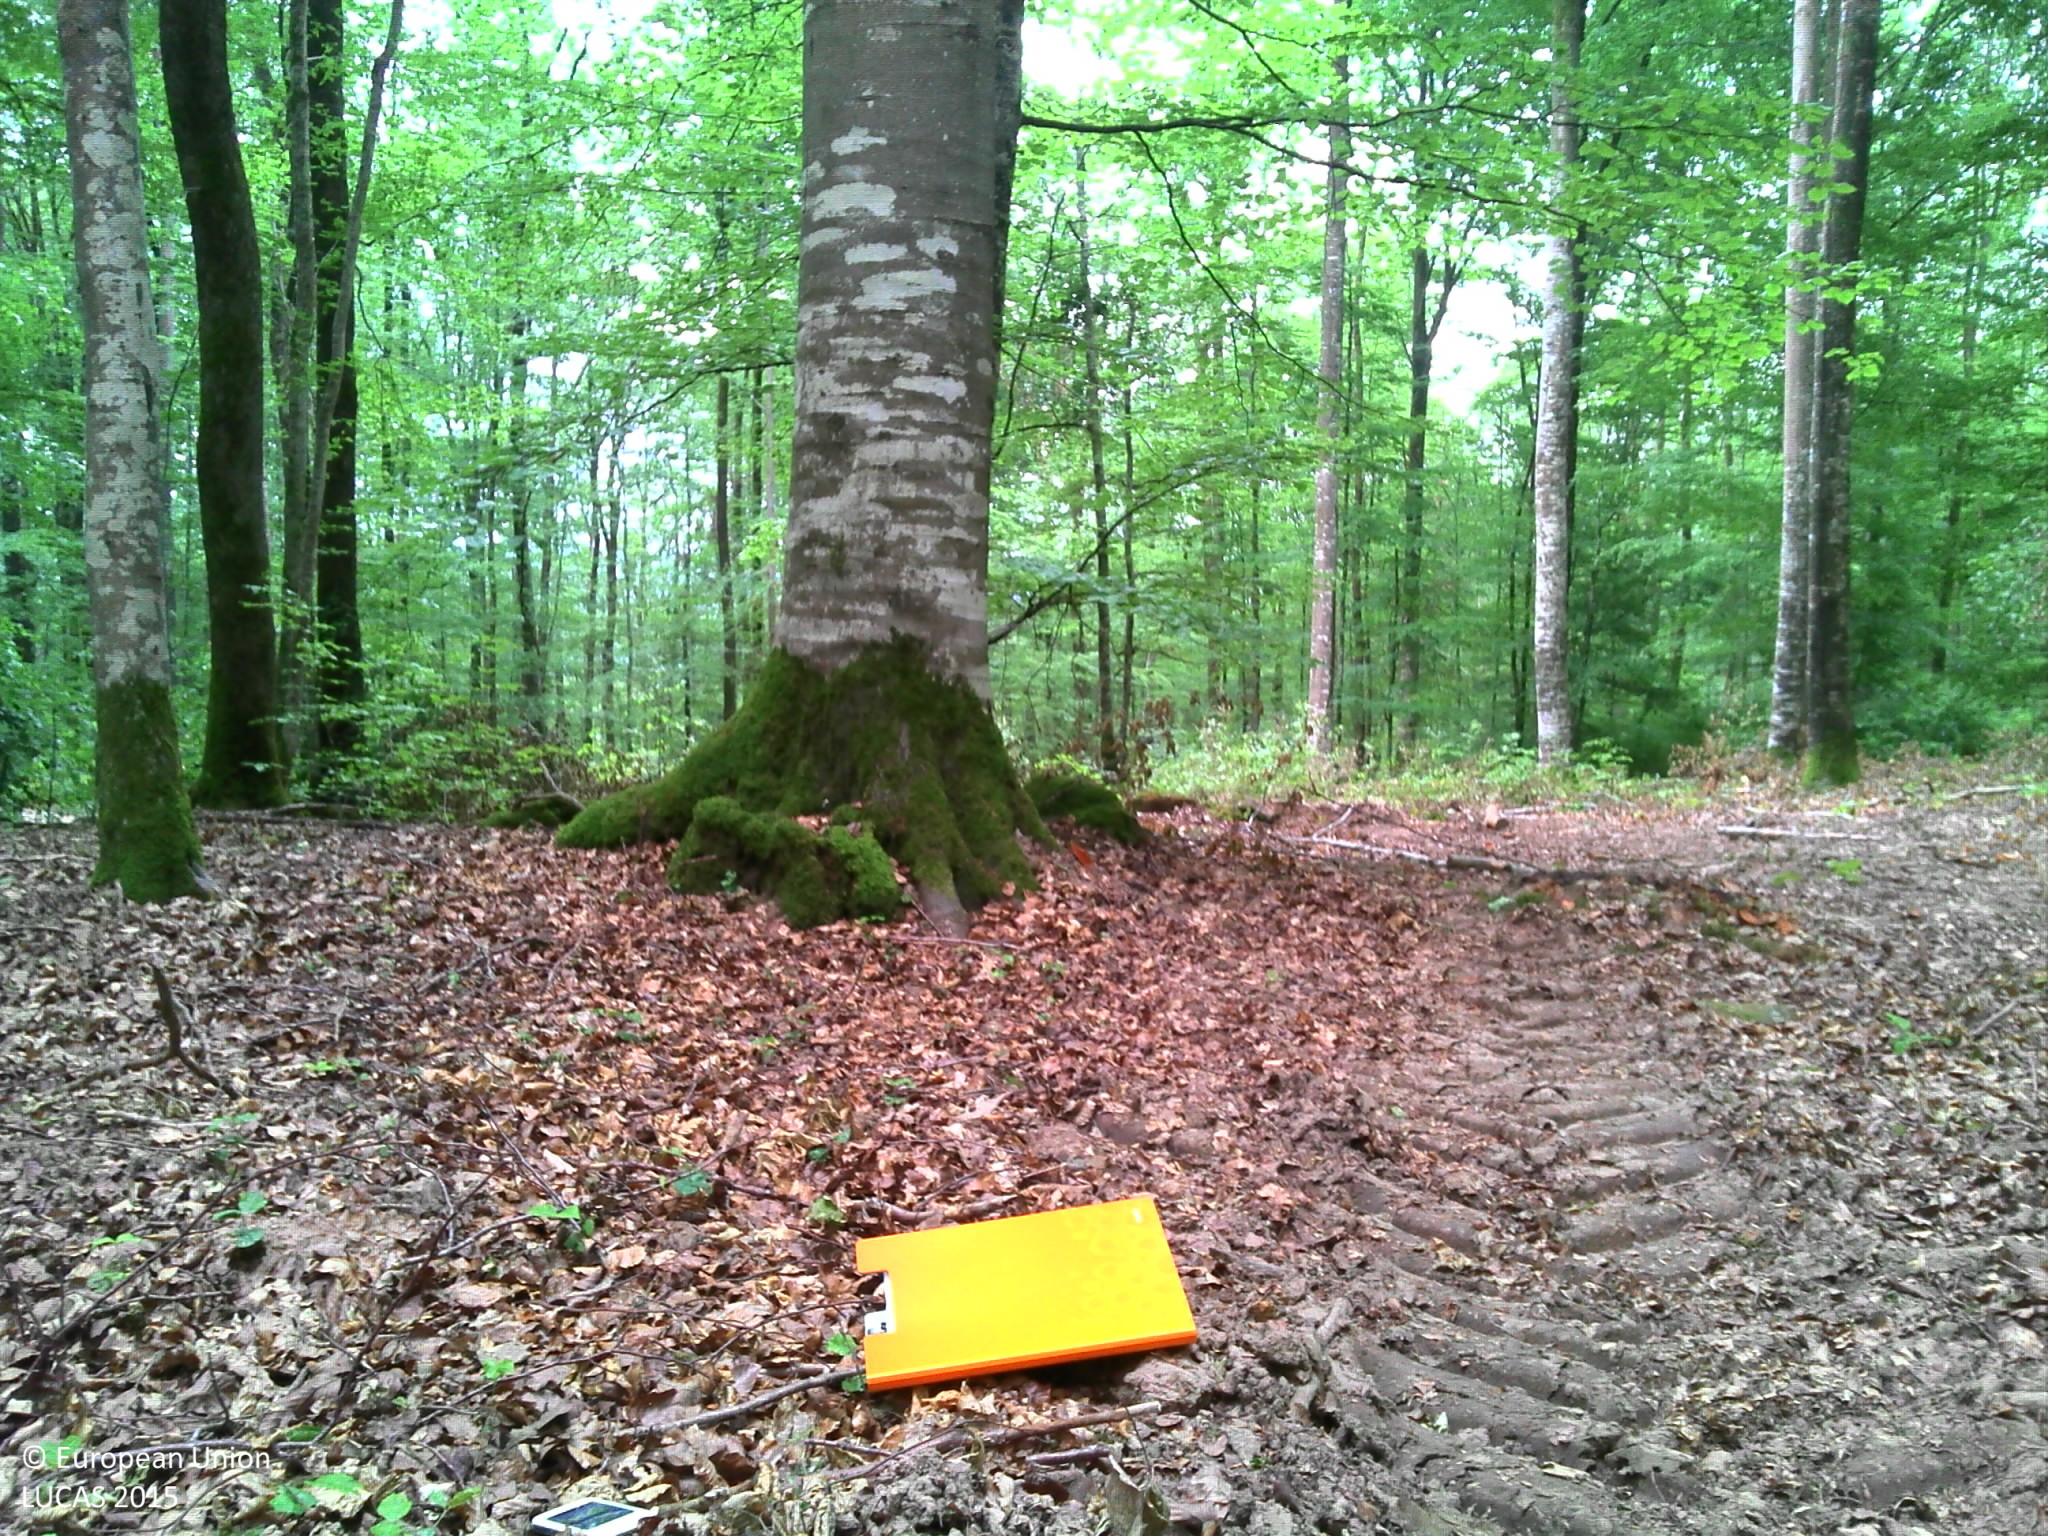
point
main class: Woodland
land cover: Broadleaved woodland
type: beech forest
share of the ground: > 75 %
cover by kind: broadleaved forest trees 90 %, coniferous forest trees 5 %, herbaceous plants 5 %
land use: Forestry
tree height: > 5 m
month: May
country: FR
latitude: 47.9925
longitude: 6.1011
